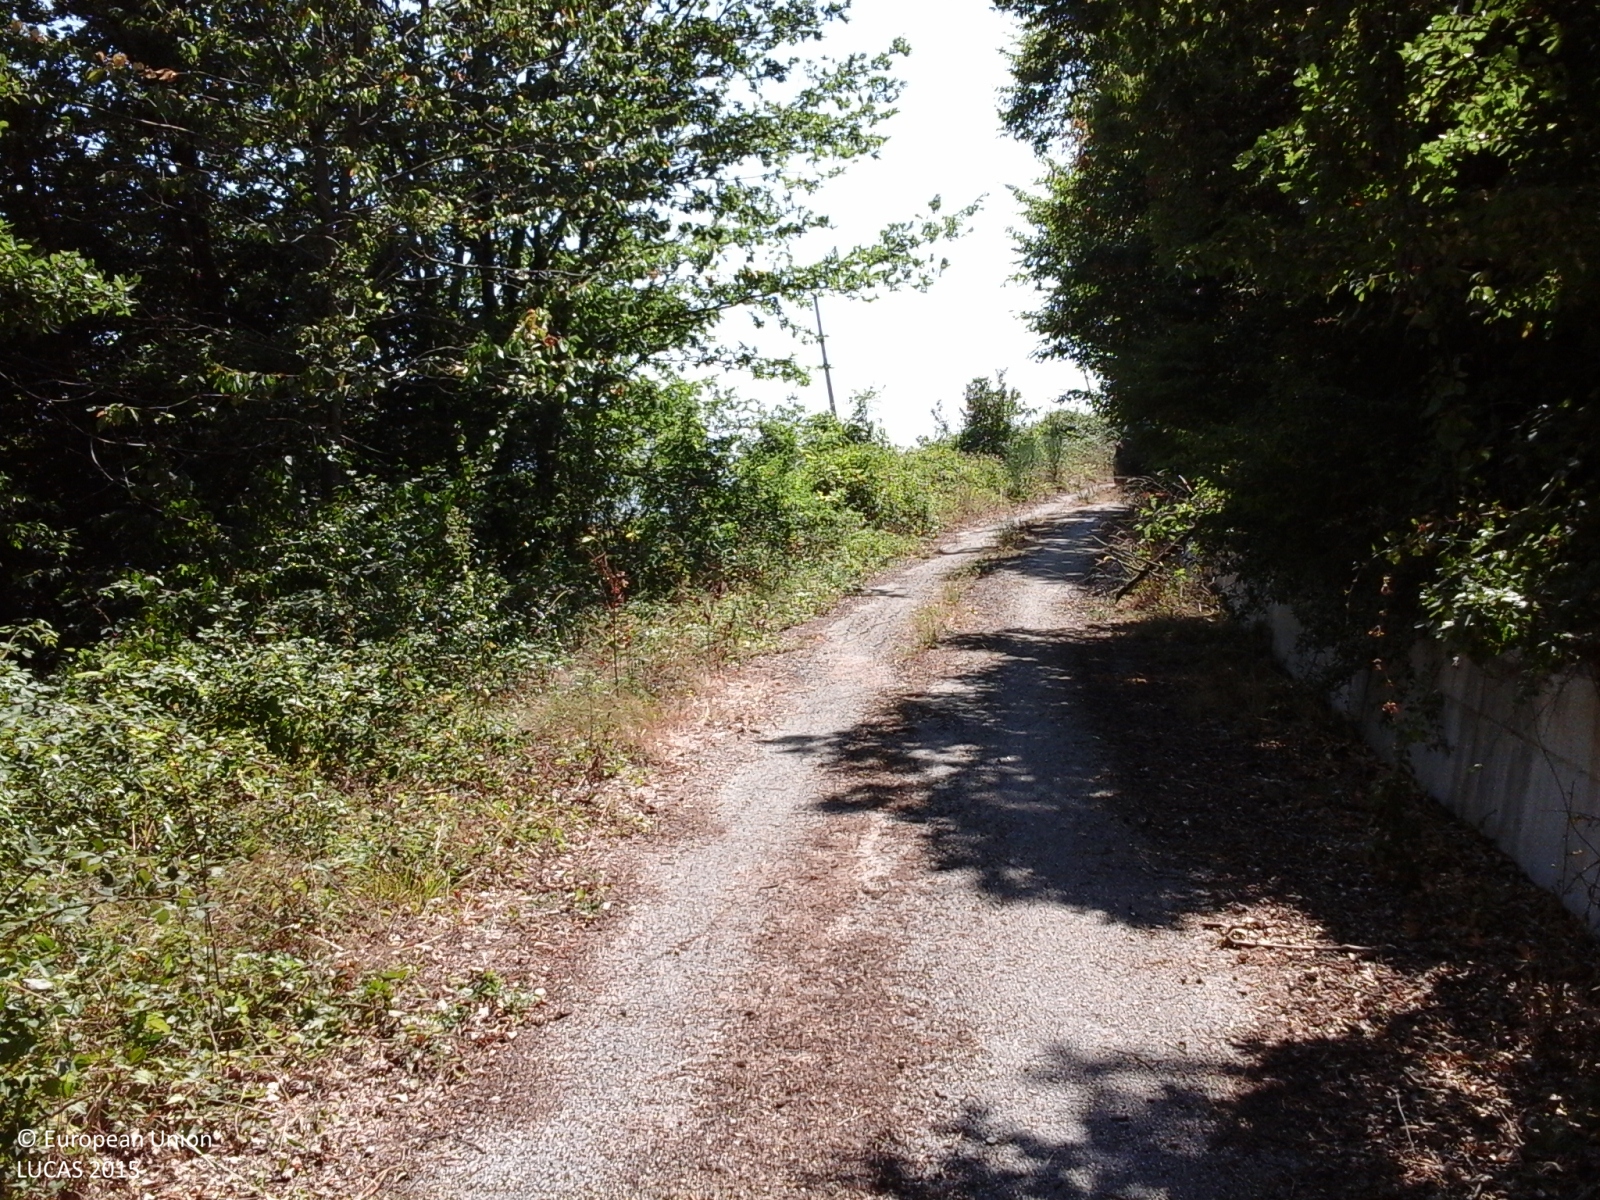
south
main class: Woodland
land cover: Broadleaved woodland
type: thermophilous deciduous forest
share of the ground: > 75 %
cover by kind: broadleaved forest trees 90 %, shrubs 5 %, herbaceous plants 5 %
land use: Semi-natural and natural areas not in use
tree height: > 5 m
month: September
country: IT
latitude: 41.6815
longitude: 14.1778
